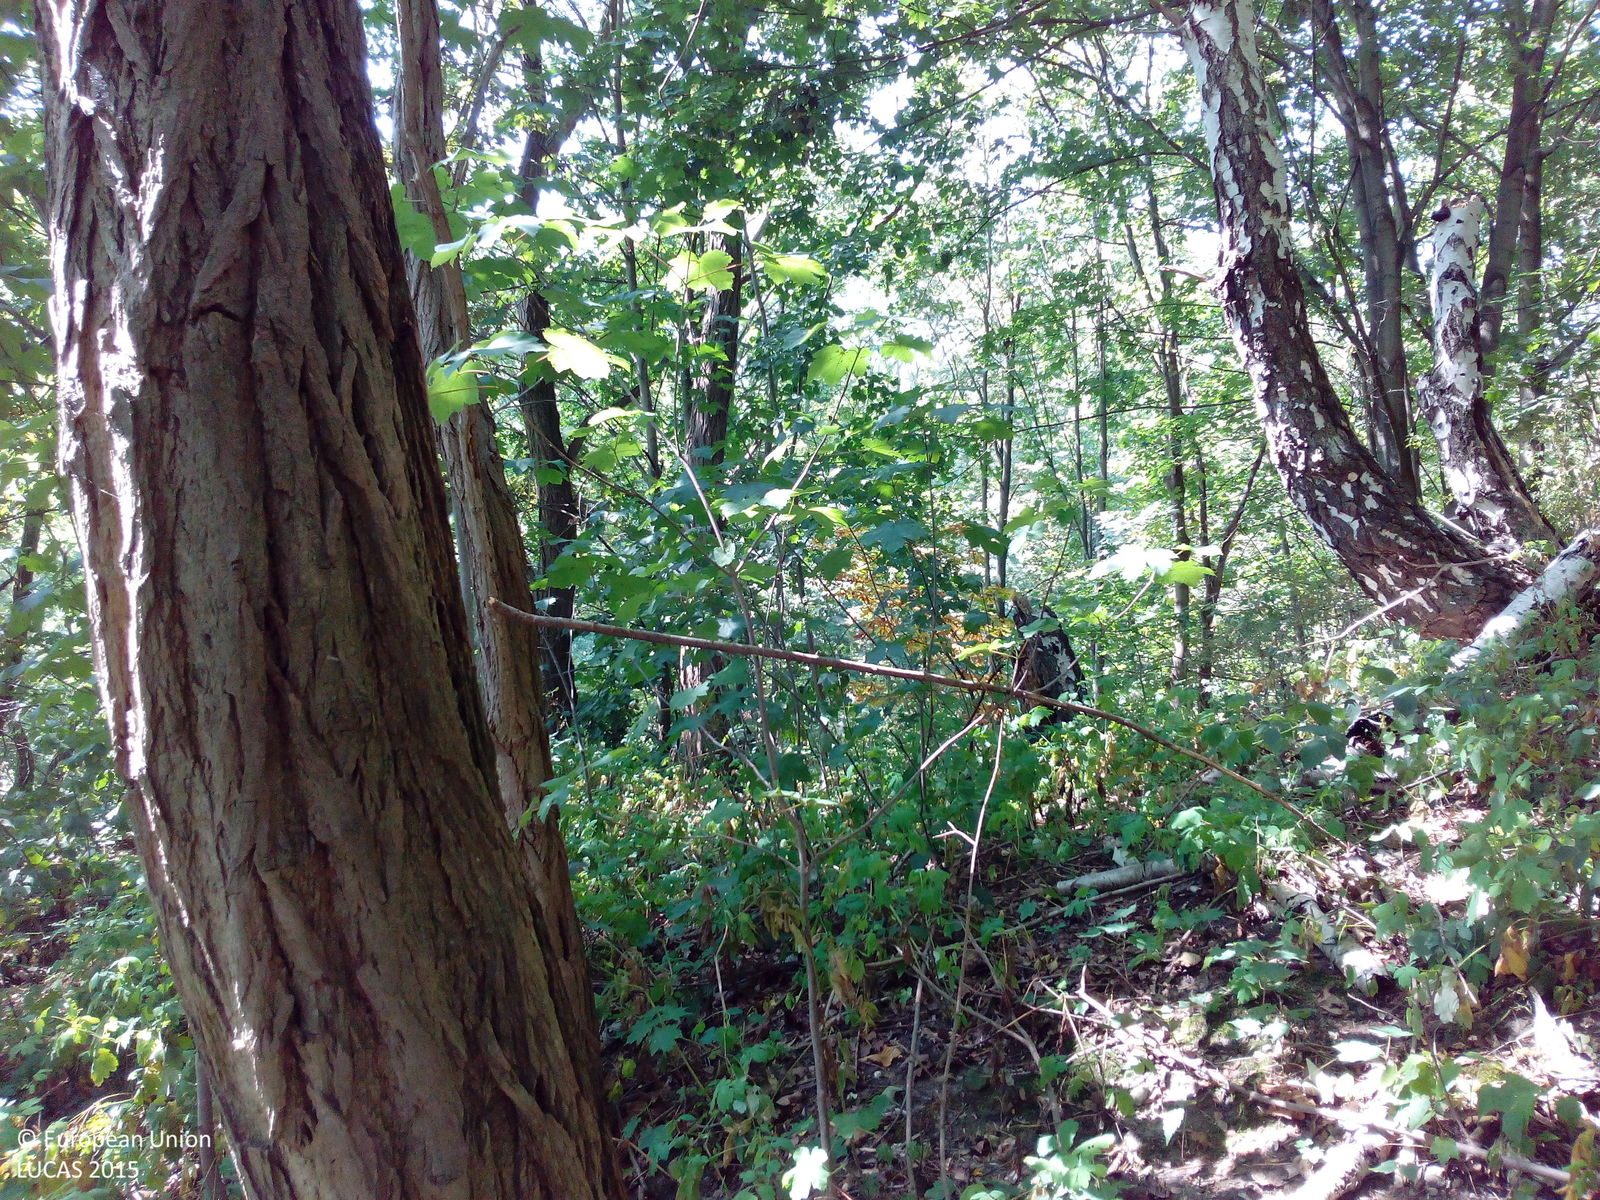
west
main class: Woodland
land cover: Broadleaved woodland
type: mesophytic deciduous forest
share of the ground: > 75 %
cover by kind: broadleaved forest trees 95 %, unconsolidated bare surface 5 %
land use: Forestry
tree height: > 5 m
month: August
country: DE
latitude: 51.8697
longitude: 11.0309
